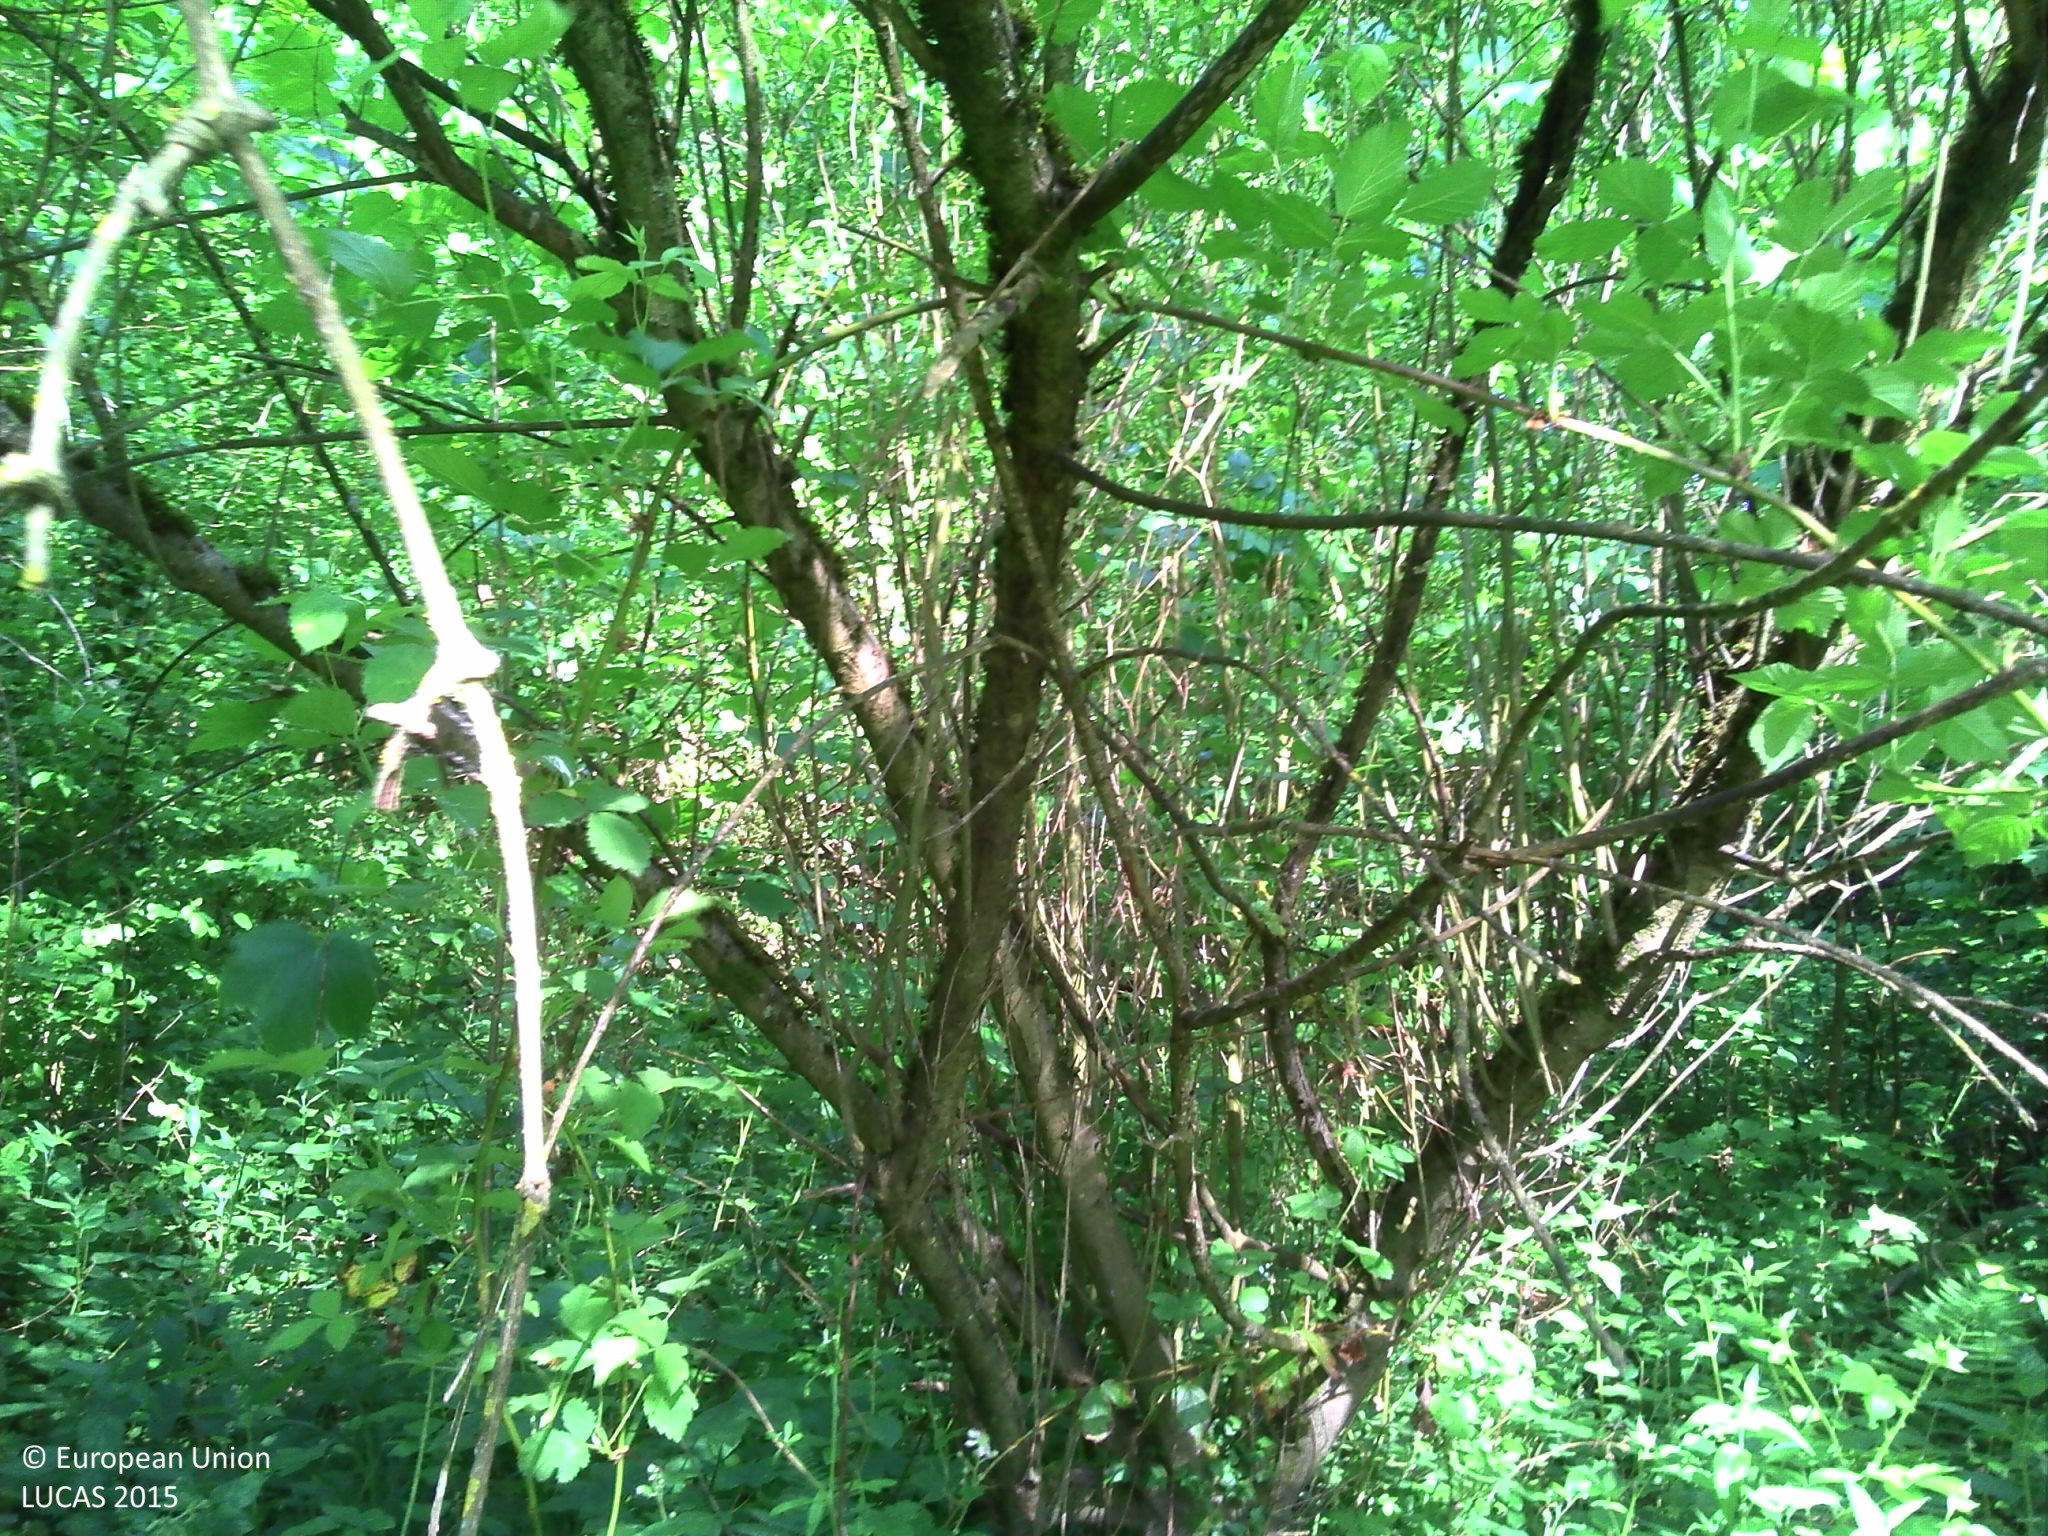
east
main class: Woodland
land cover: Broadleaved woodland
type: mesophytic deciduous forest
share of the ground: > 75 %
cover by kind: broadleaved forest trees 70 %, herbaceous plants 30 %
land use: Forestry
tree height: > 5 m
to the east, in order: Broadleaved woodland; Tracks; Broadleaved woodland; Inland fresh running water; Broadleaved woodland; Artificial constructions in urban areas
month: June
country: BE
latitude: 50.4792
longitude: 5.6440
